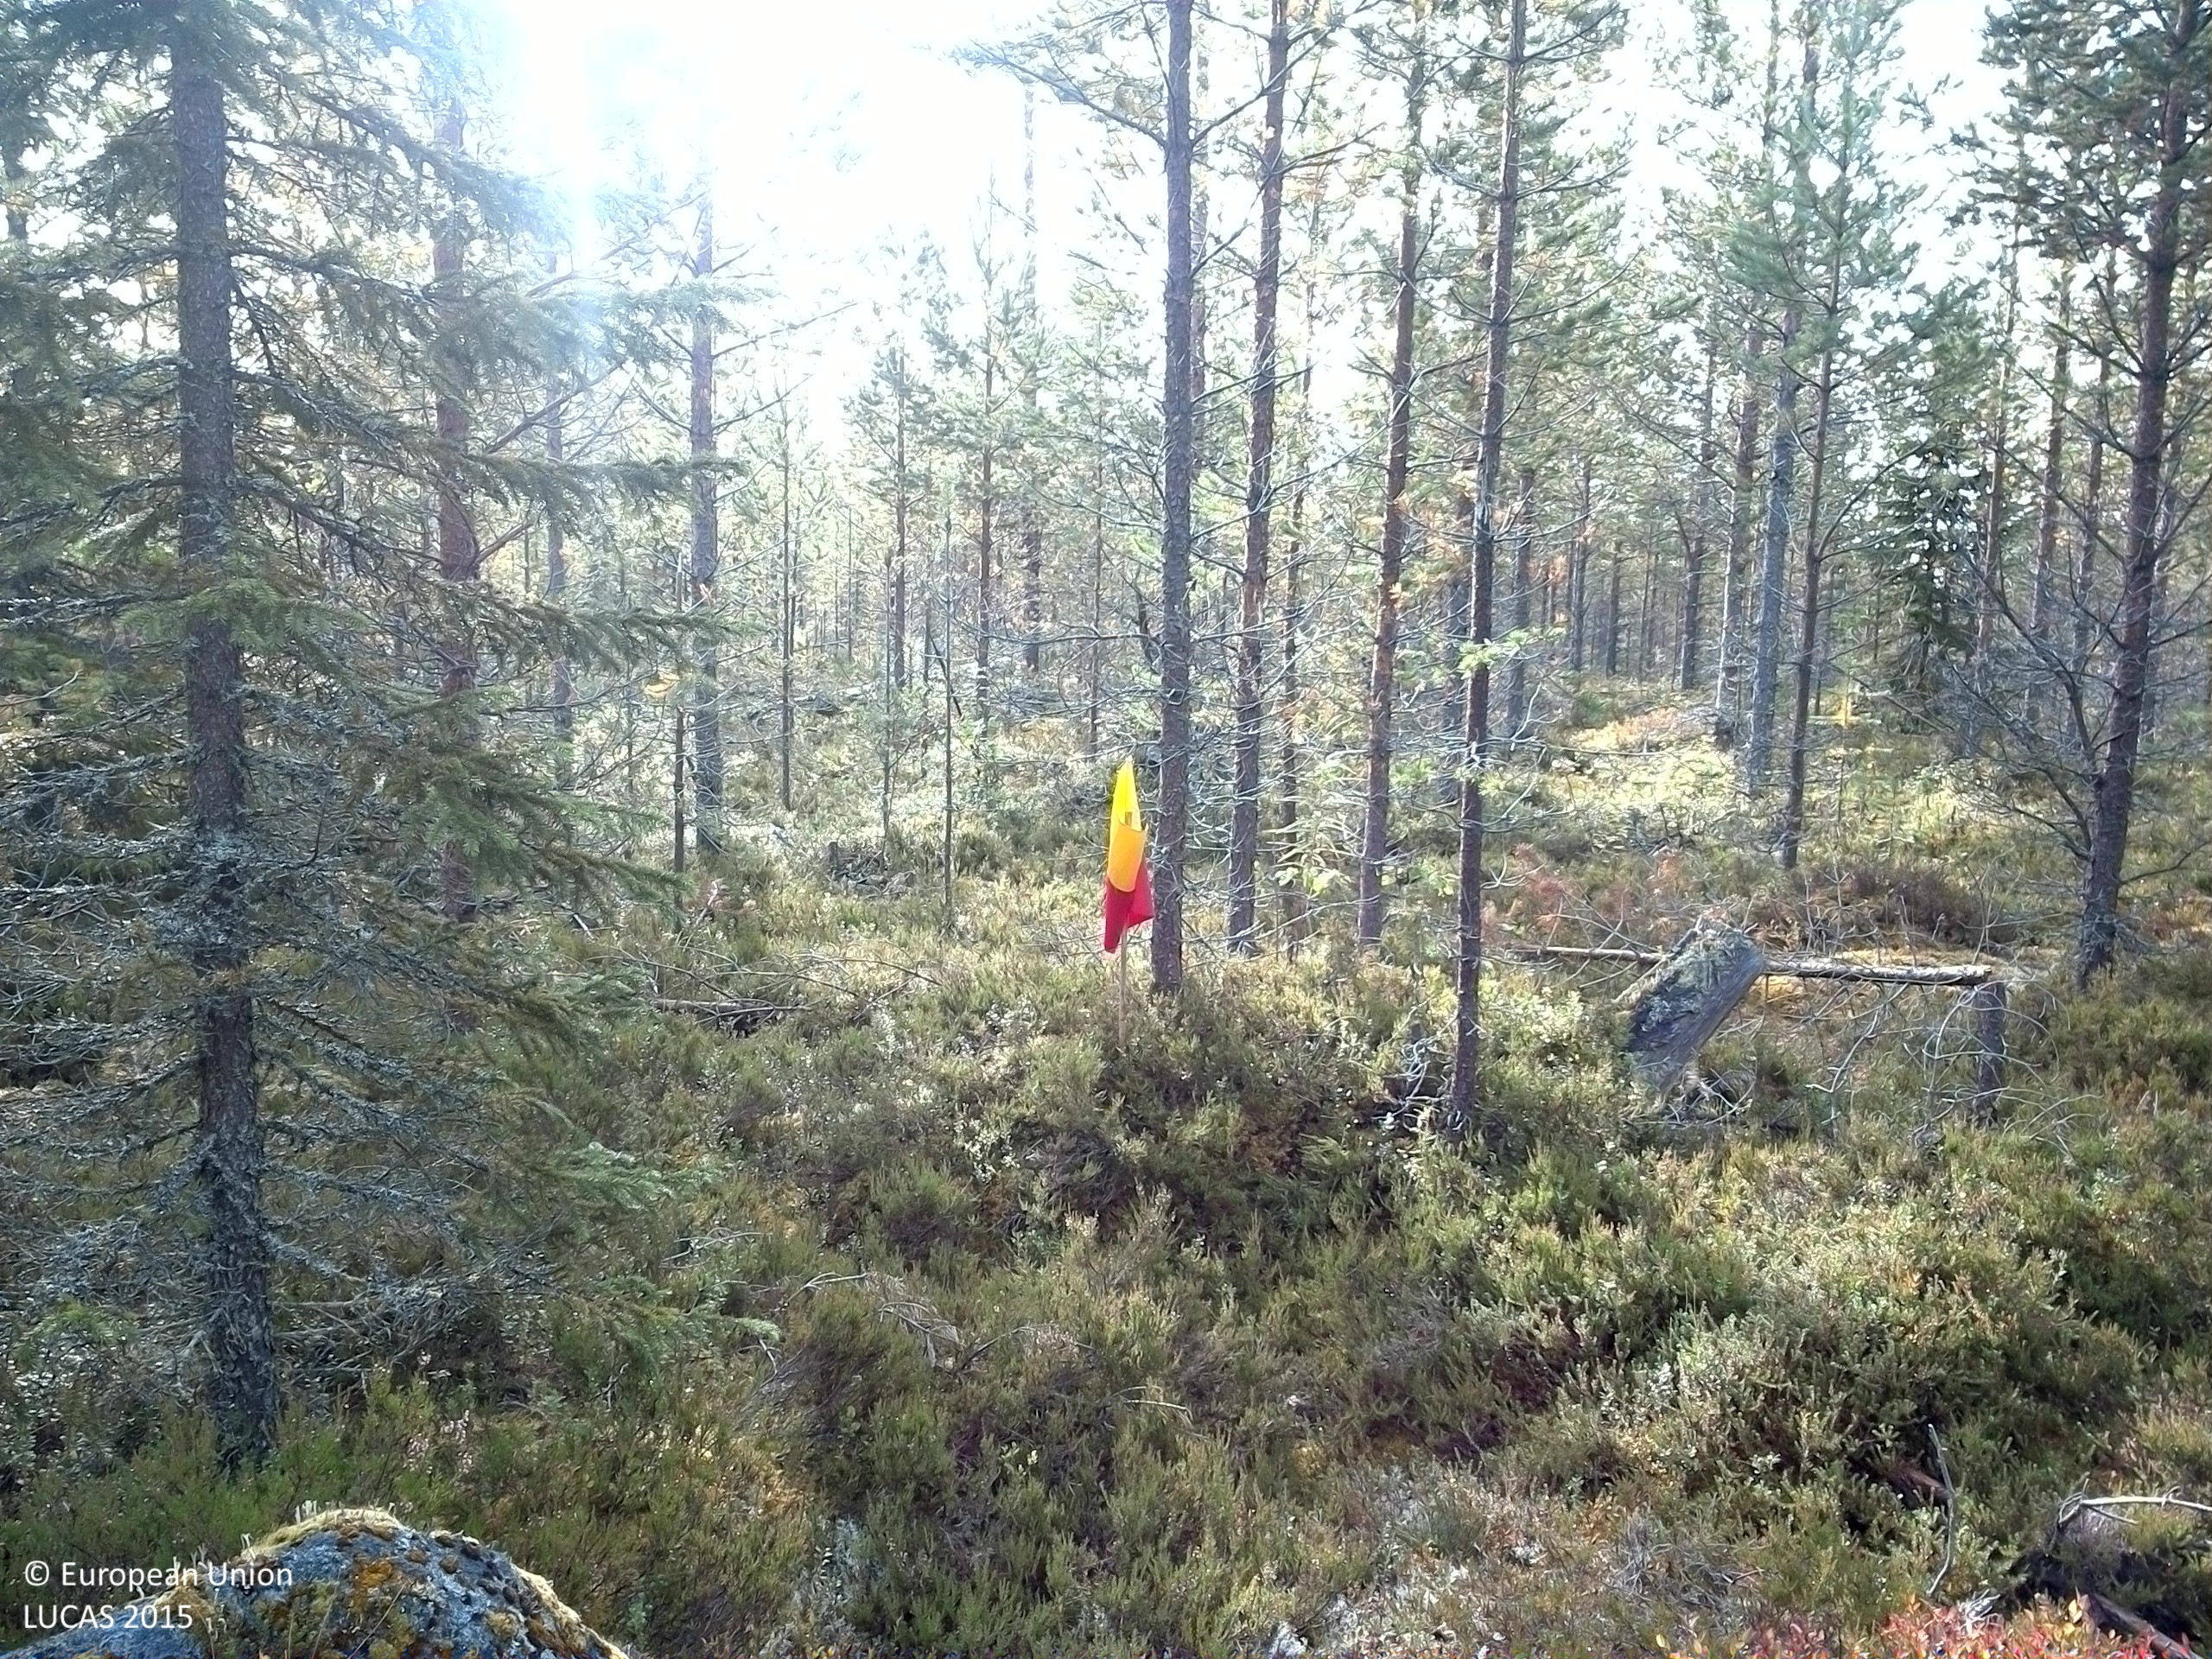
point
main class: Woodland
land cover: Pine dominated coniferous woodland
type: boreal forest
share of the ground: 25 - 50 %
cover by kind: shrubs 45 %, coniferous forest trees 35 %, lichens and mosses 15 %, broadleaved forest trees 5 %
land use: Forestry
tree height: > 5 m
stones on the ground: 10 - 25 %
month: September
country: SE
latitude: 63.9901
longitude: 16.5725
